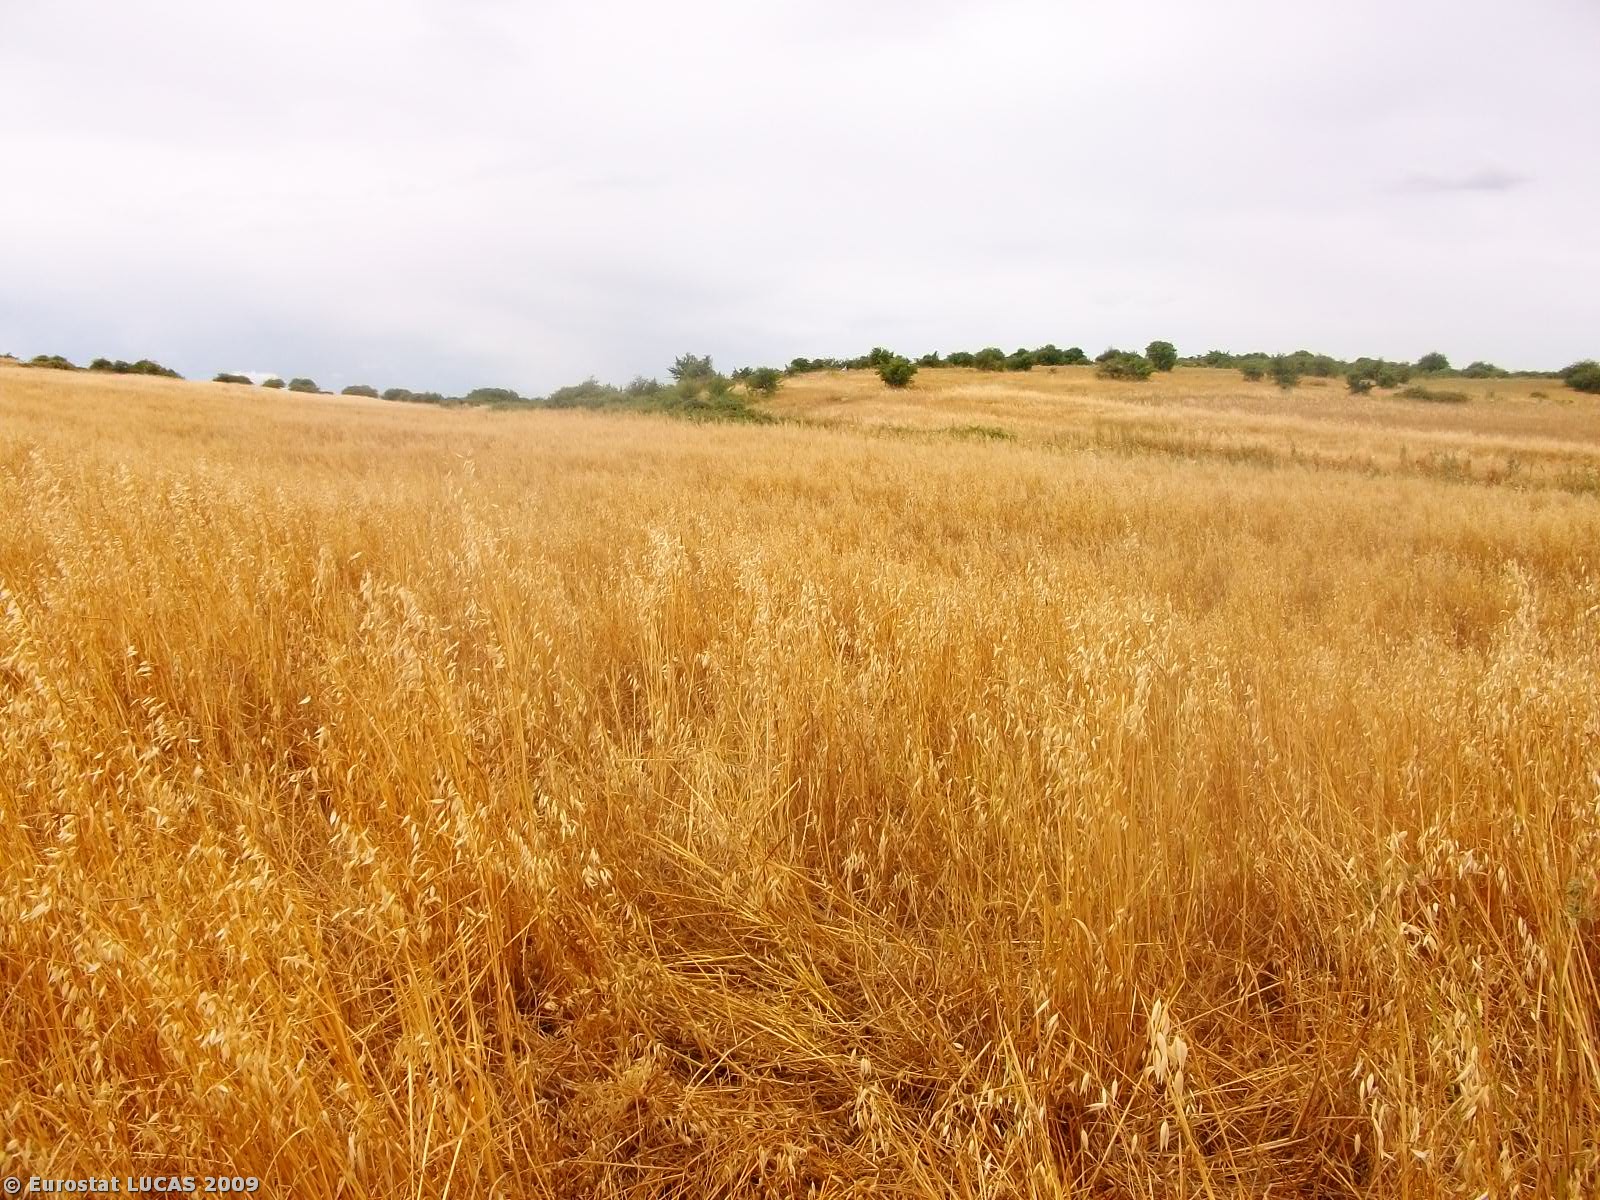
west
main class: Cropland
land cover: Durum wheat
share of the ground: > 75 %
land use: Agriculture (excluding fallow land and kitchen gardens)
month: June
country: GR
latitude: 40.9697
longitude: 22.7353
